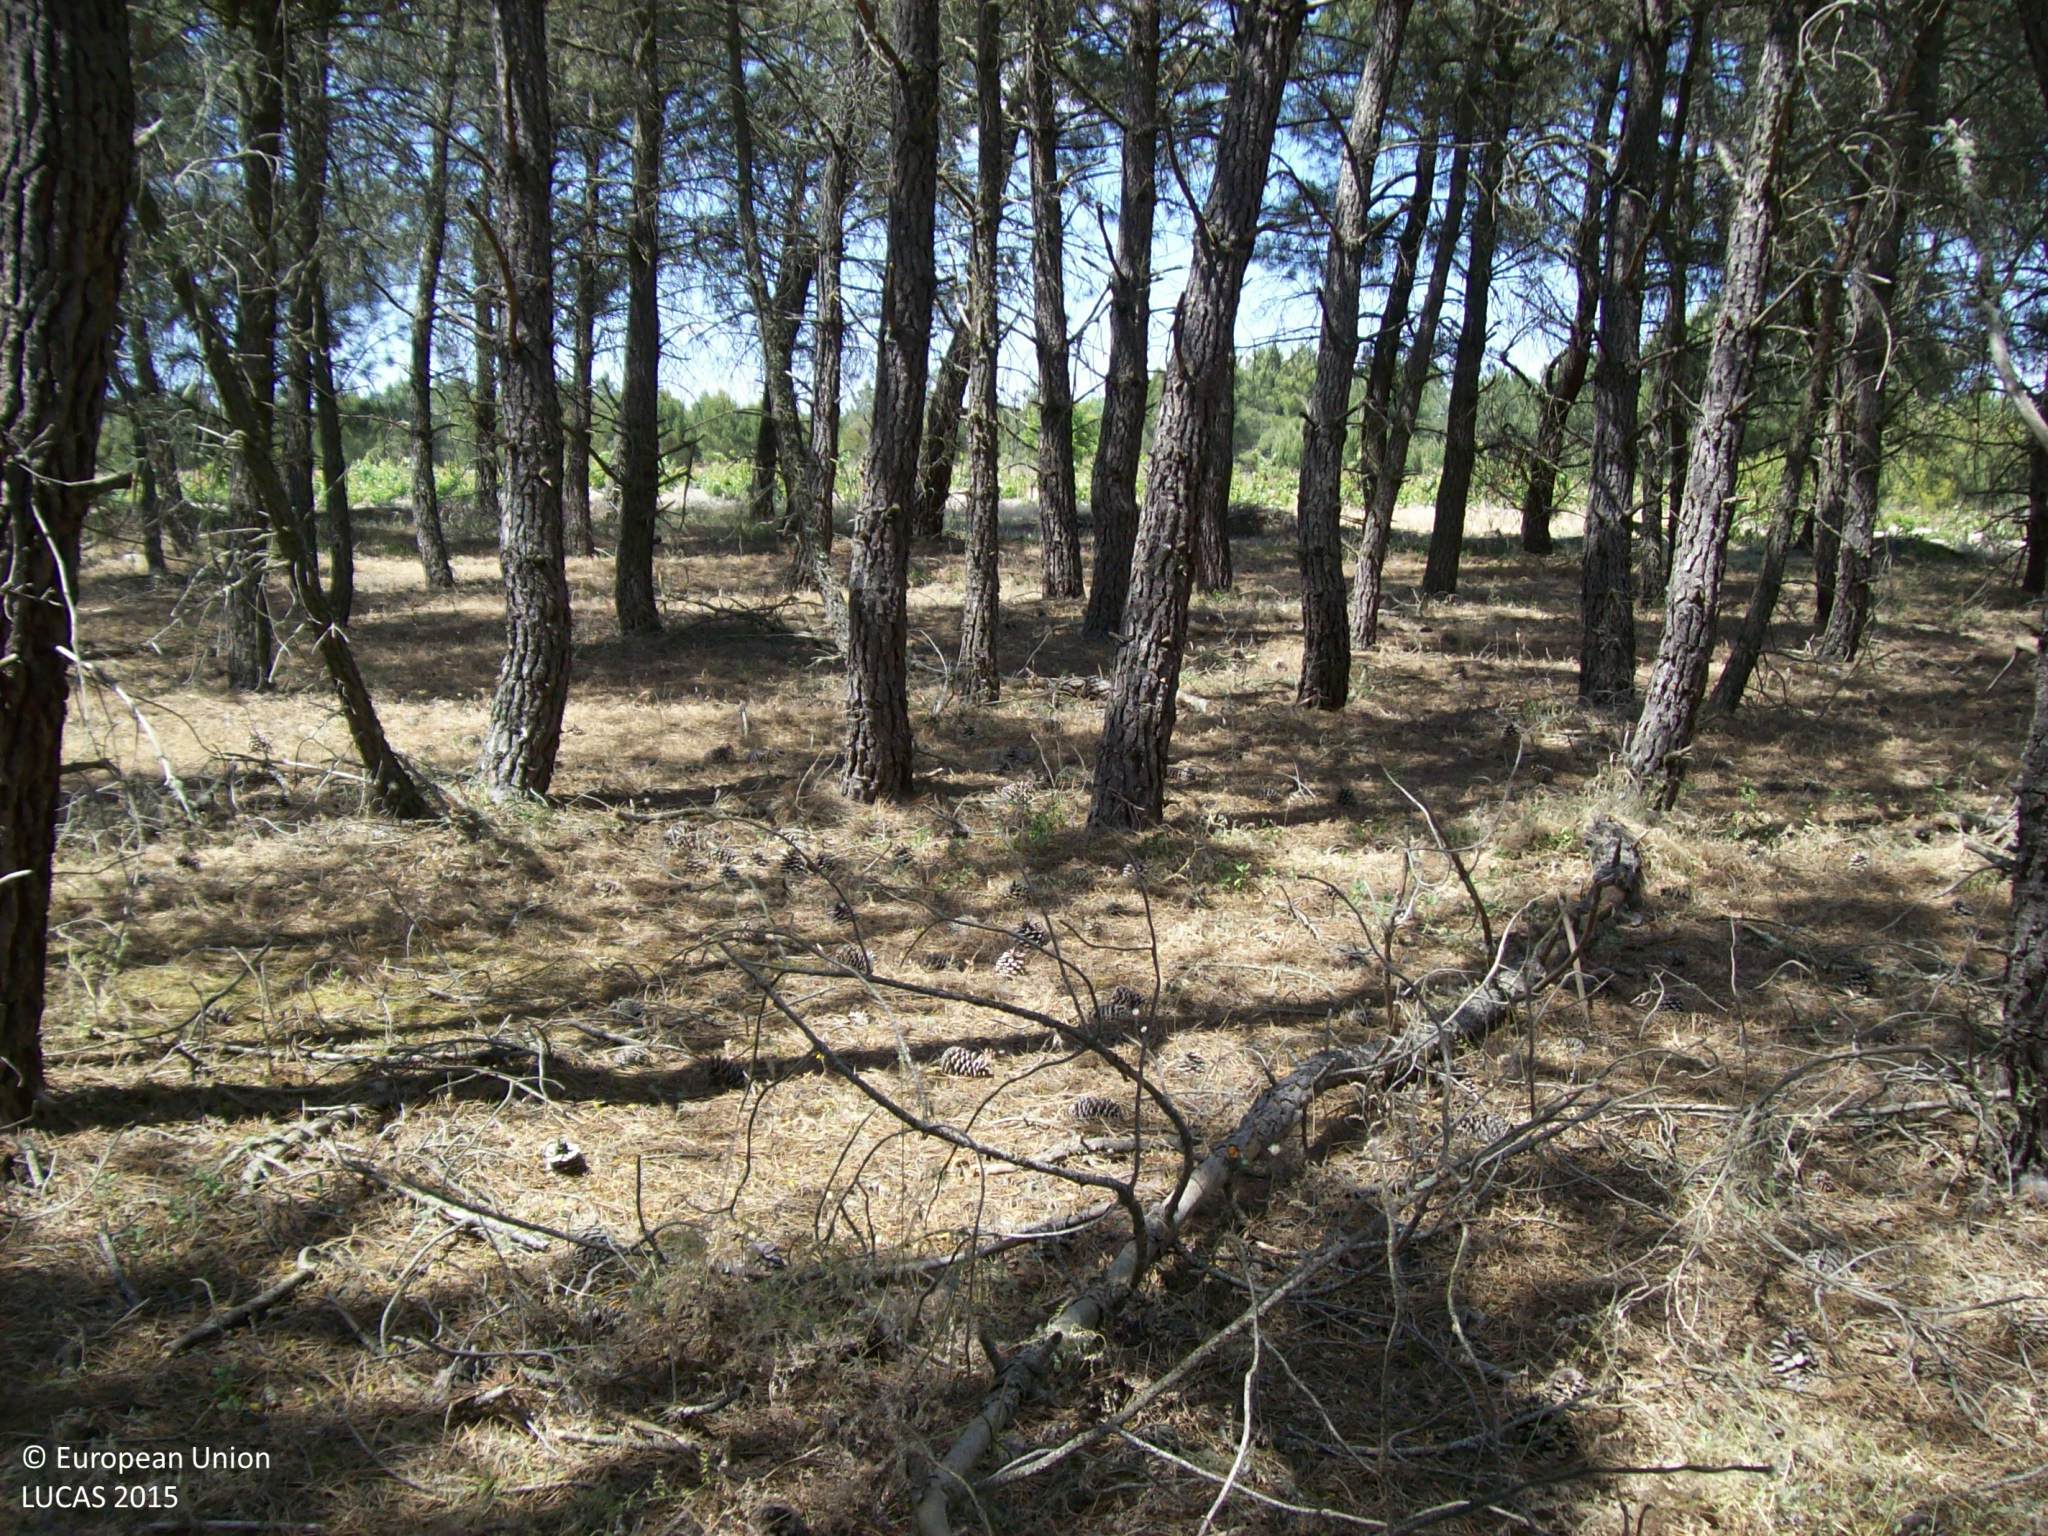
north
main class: Woodland
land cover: Pine dominated coniferous woodland
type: coniferous forest of the mediterranean region
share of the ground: 50 - 75 %
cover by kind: coniferous forest trees 60 %, unconsolidated bare surface 30 %, herbaceous plants 5 %, lichens and mosses 5 %
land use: Forestry
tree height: > 5 m
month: June
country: ES
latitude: 41.1588
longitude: -4.5389
